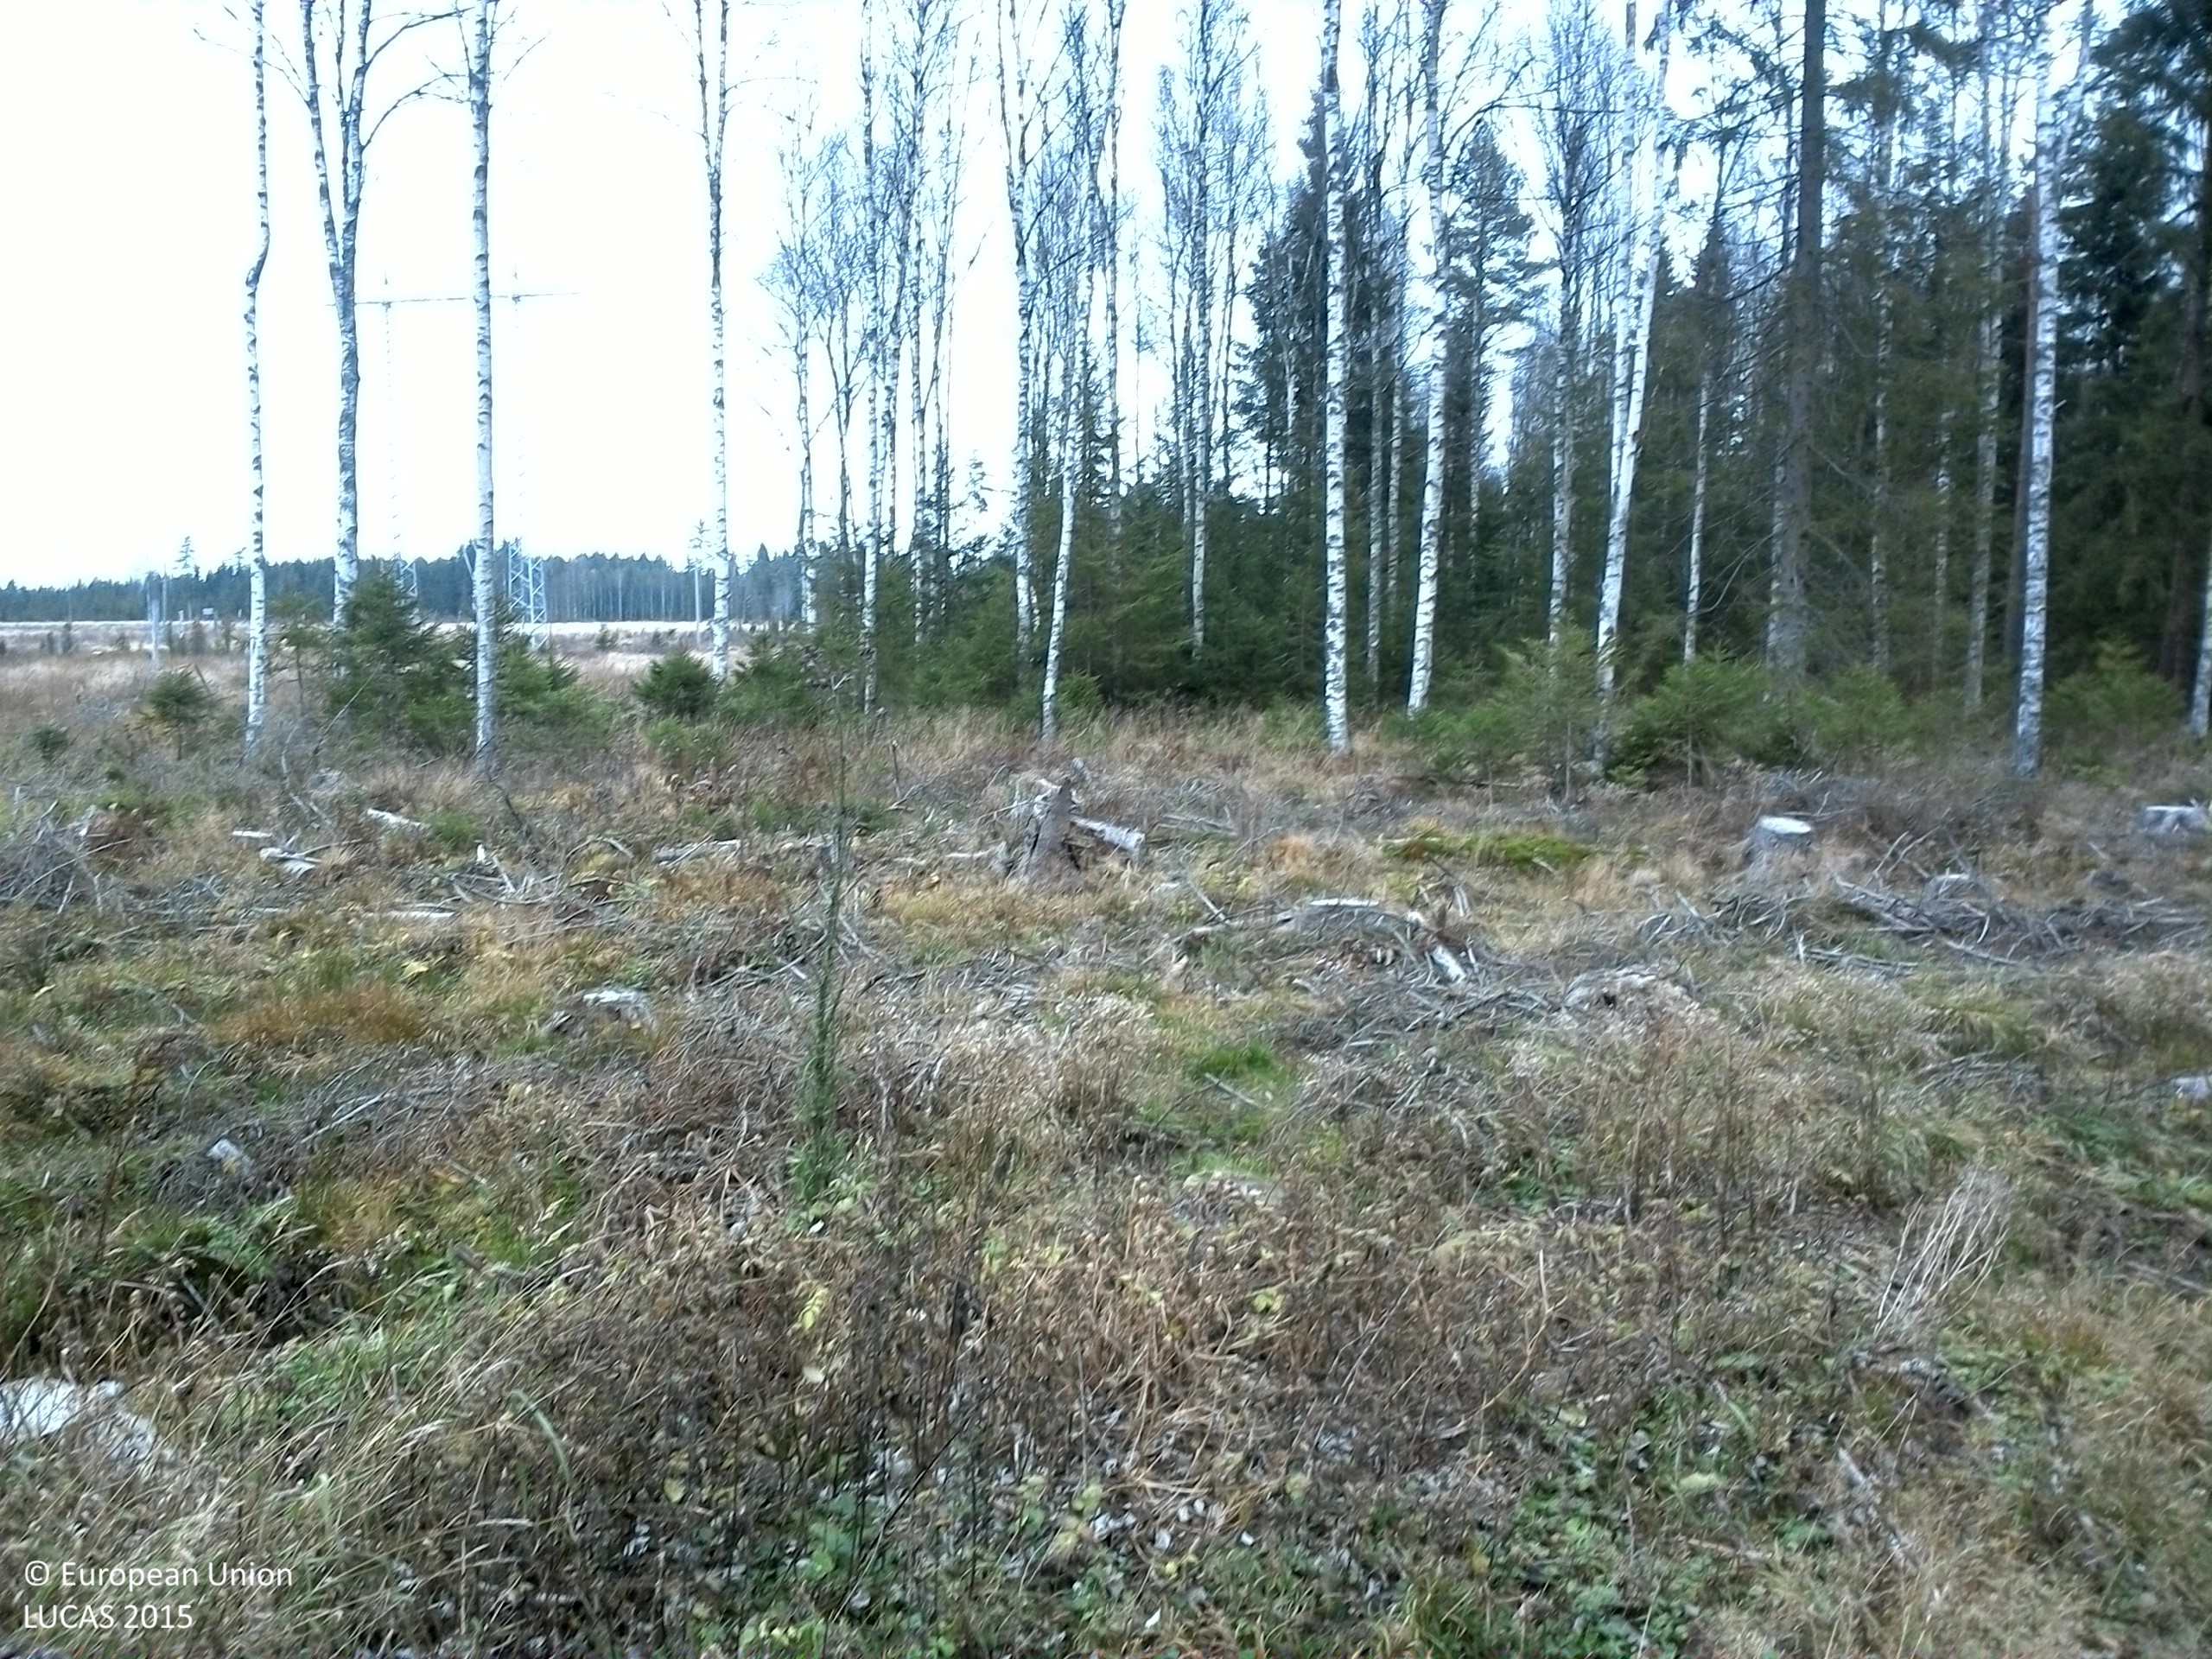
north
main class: Grassland
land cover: Grassland with sparse tree/shrub cover
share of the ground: > 75 %
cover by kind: herbaceous plants 90 %, coniferous forest trees 5 %, shrubs 5 %
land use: Forestry
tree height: < 5 m
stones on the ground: < 10 %
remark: Clear cut
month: November
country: SE
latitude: 57.8289
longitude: 14.7606
